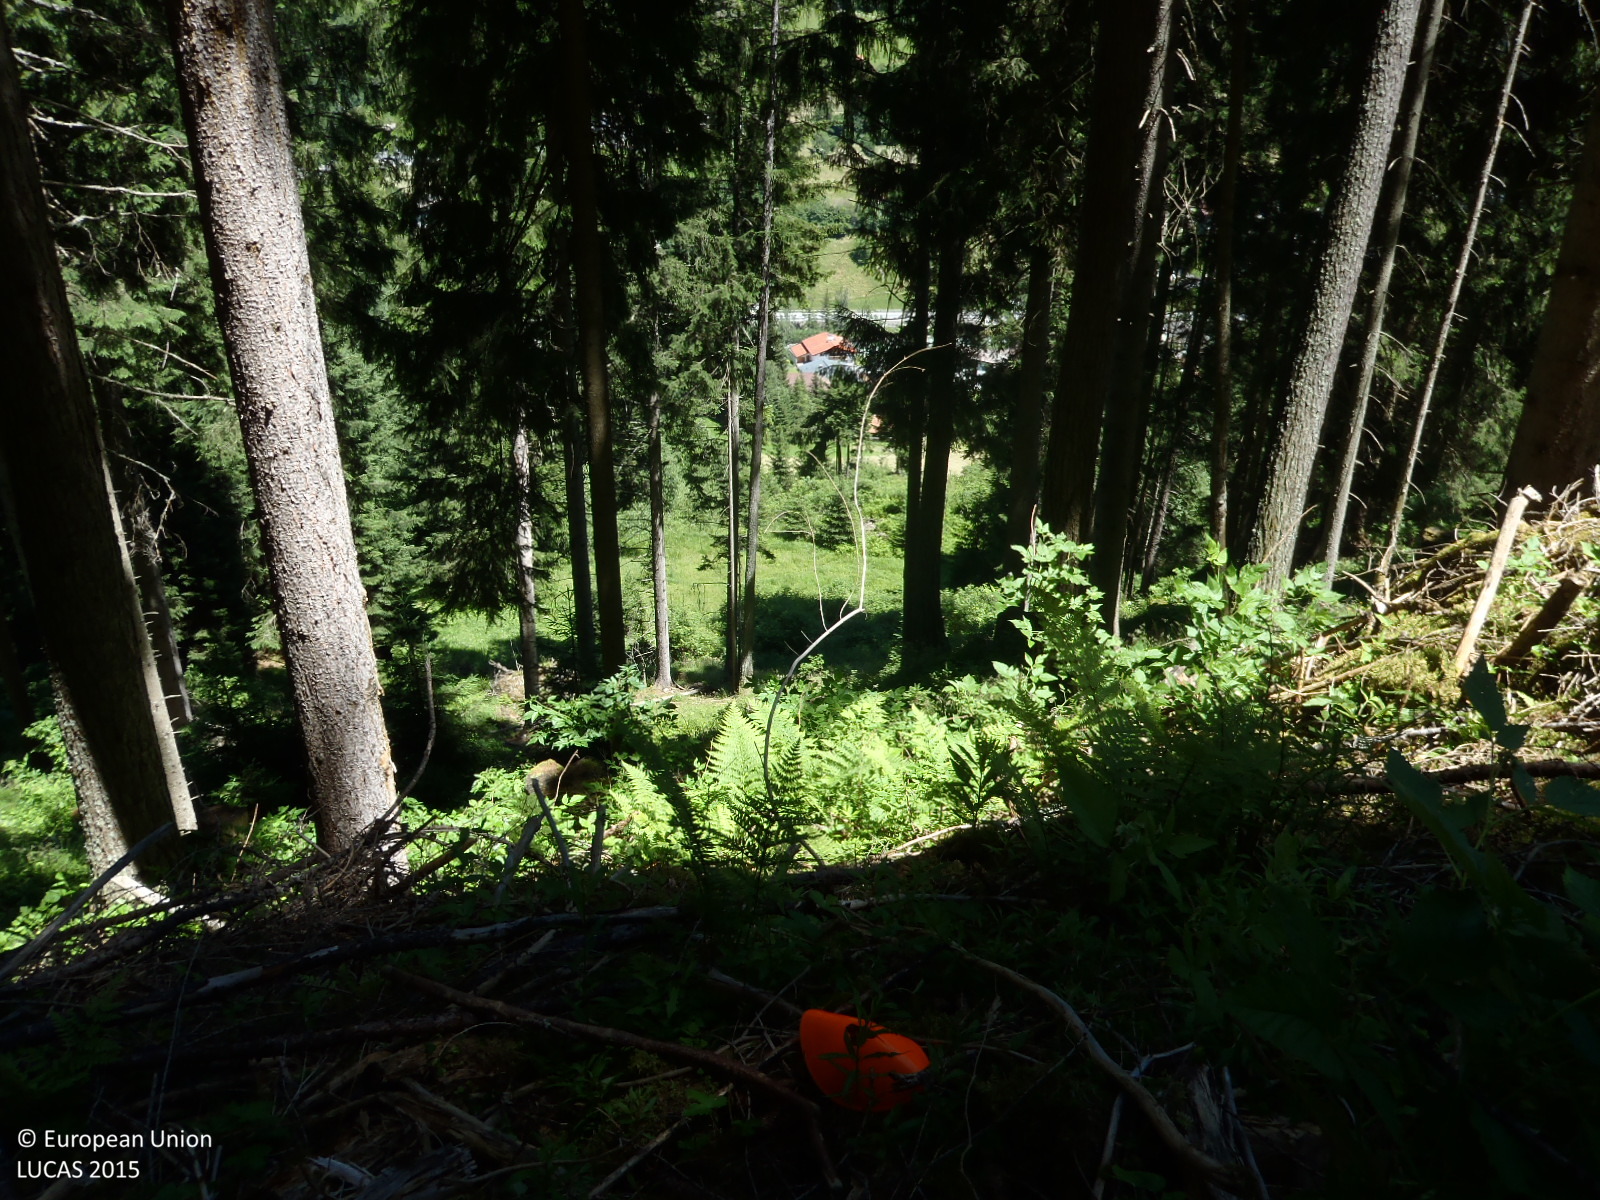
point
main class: Woodland
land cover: Spruce dominated coniferous woodland
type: alpine coniferous forest
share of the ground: > 75 %
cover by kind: coniferous forest trees 90 %, herbaceous plants 10 %
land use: Forestry
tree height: > 5 m
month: June
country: AT
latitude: 47.1428
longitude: 10.4084
